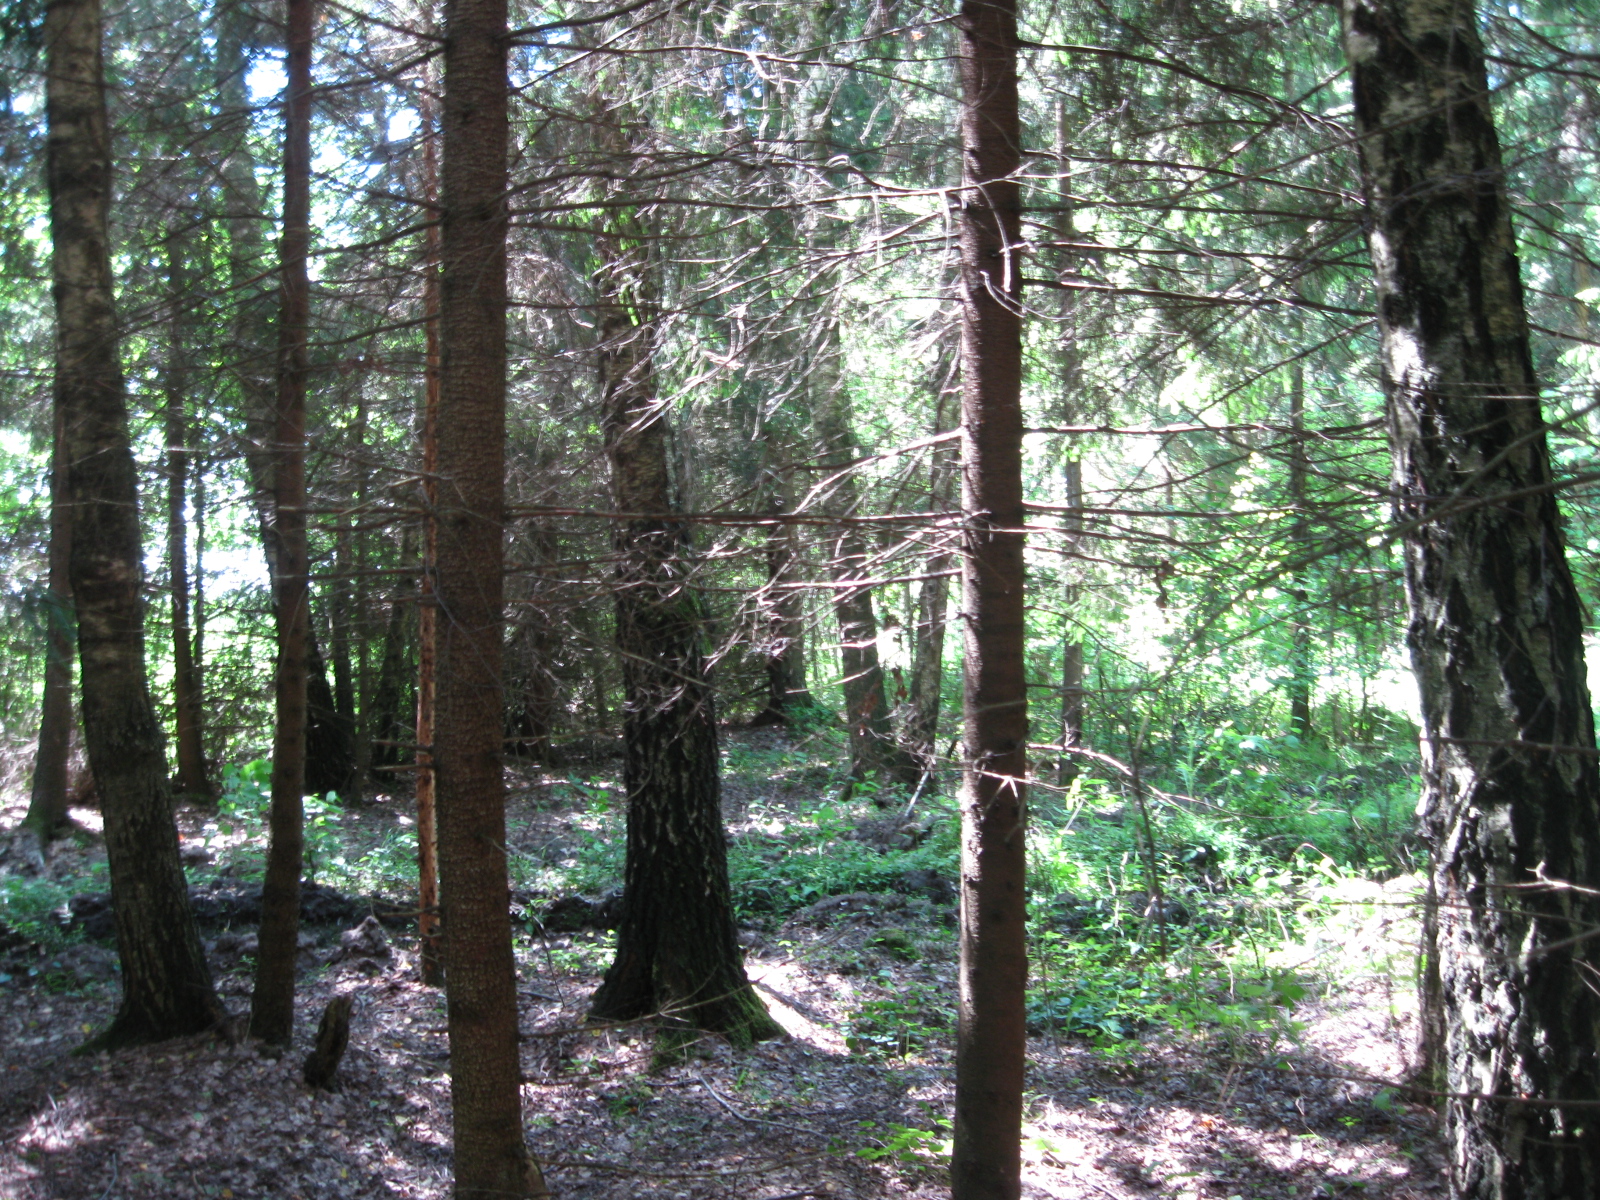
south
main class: Woodland
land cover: Spruce dominated mixed woodland
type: hemiboreal forest and nemoral coniferous forest and mixed broadleaved-coniferous forest
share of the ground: > 75 %
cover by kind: coniferous forest trees 70 %, broadleaved forest trees 30 %
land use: Forestry
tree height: > 5 m
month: June
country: LT
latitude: 55.1326
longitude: 23.7466
